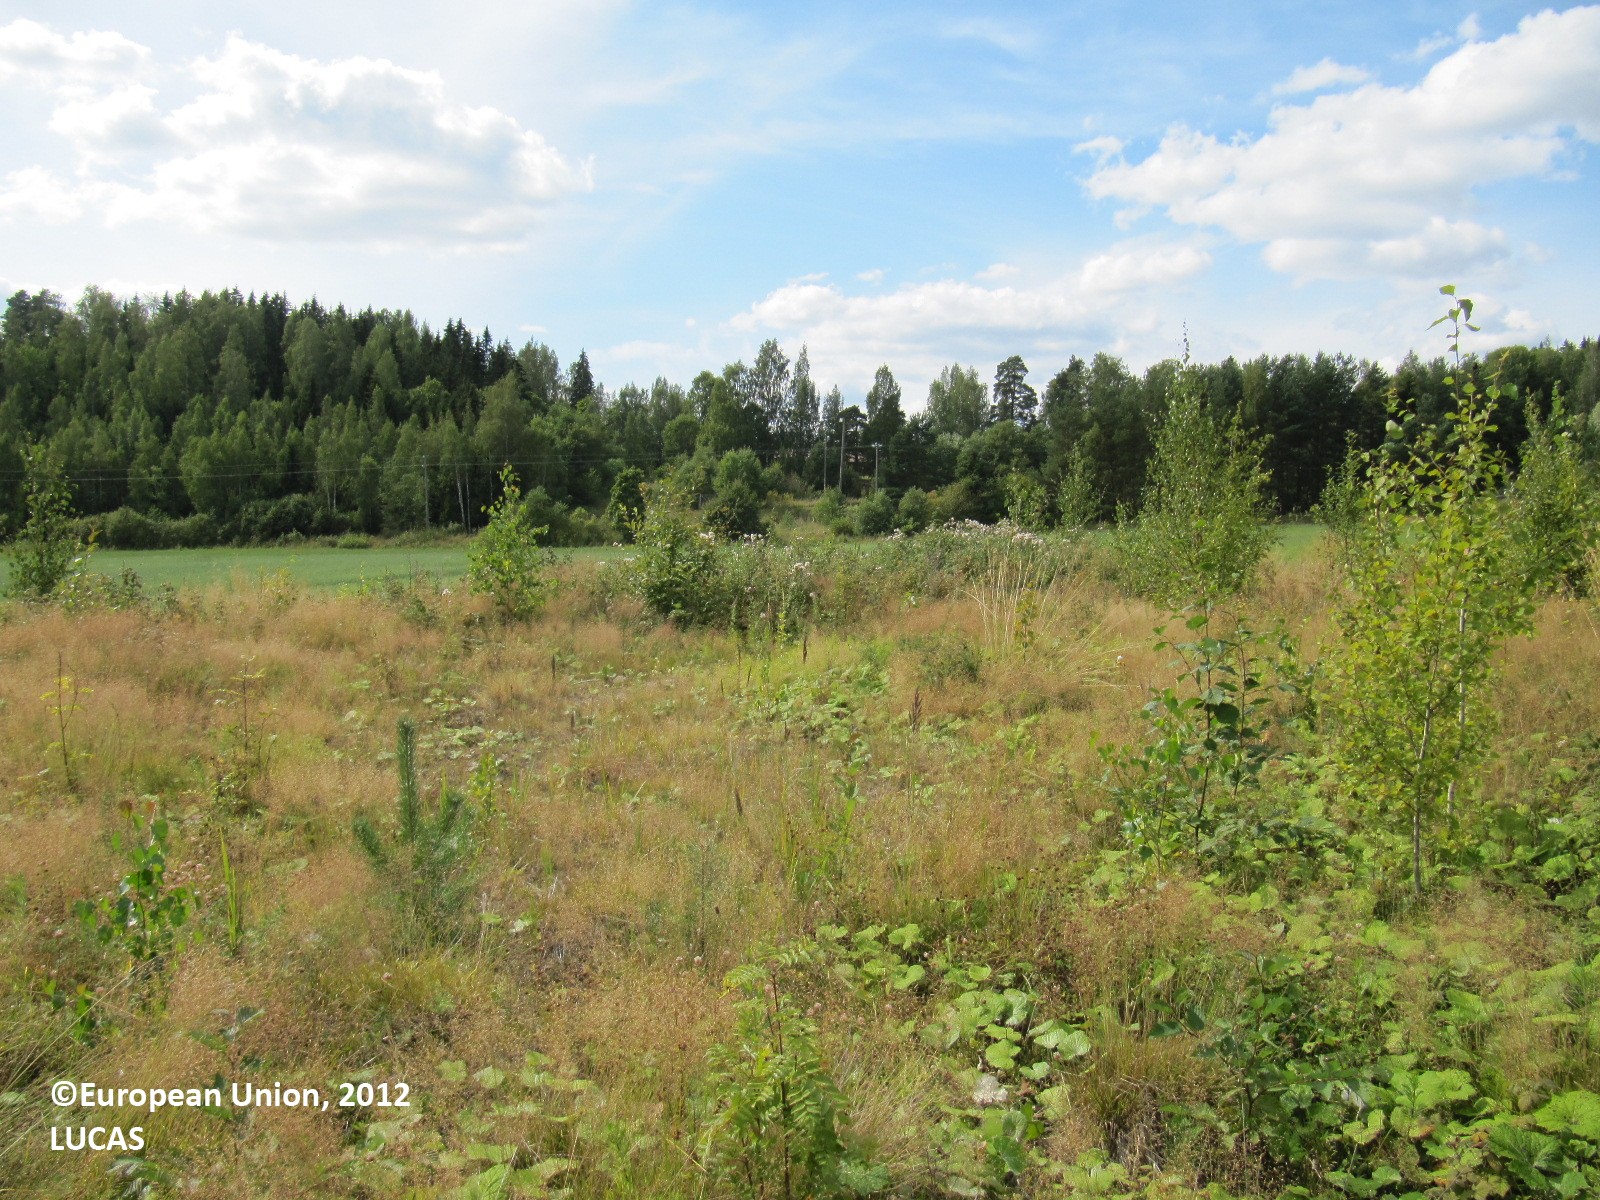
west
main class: Grassland
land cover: Grassland with sparse tree/shrub cover
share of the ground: > 75 %
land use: Semi-natural and natural areas not in use
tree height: < 5 m
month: August
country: FI
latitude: 60.3815
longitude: 24.3063
